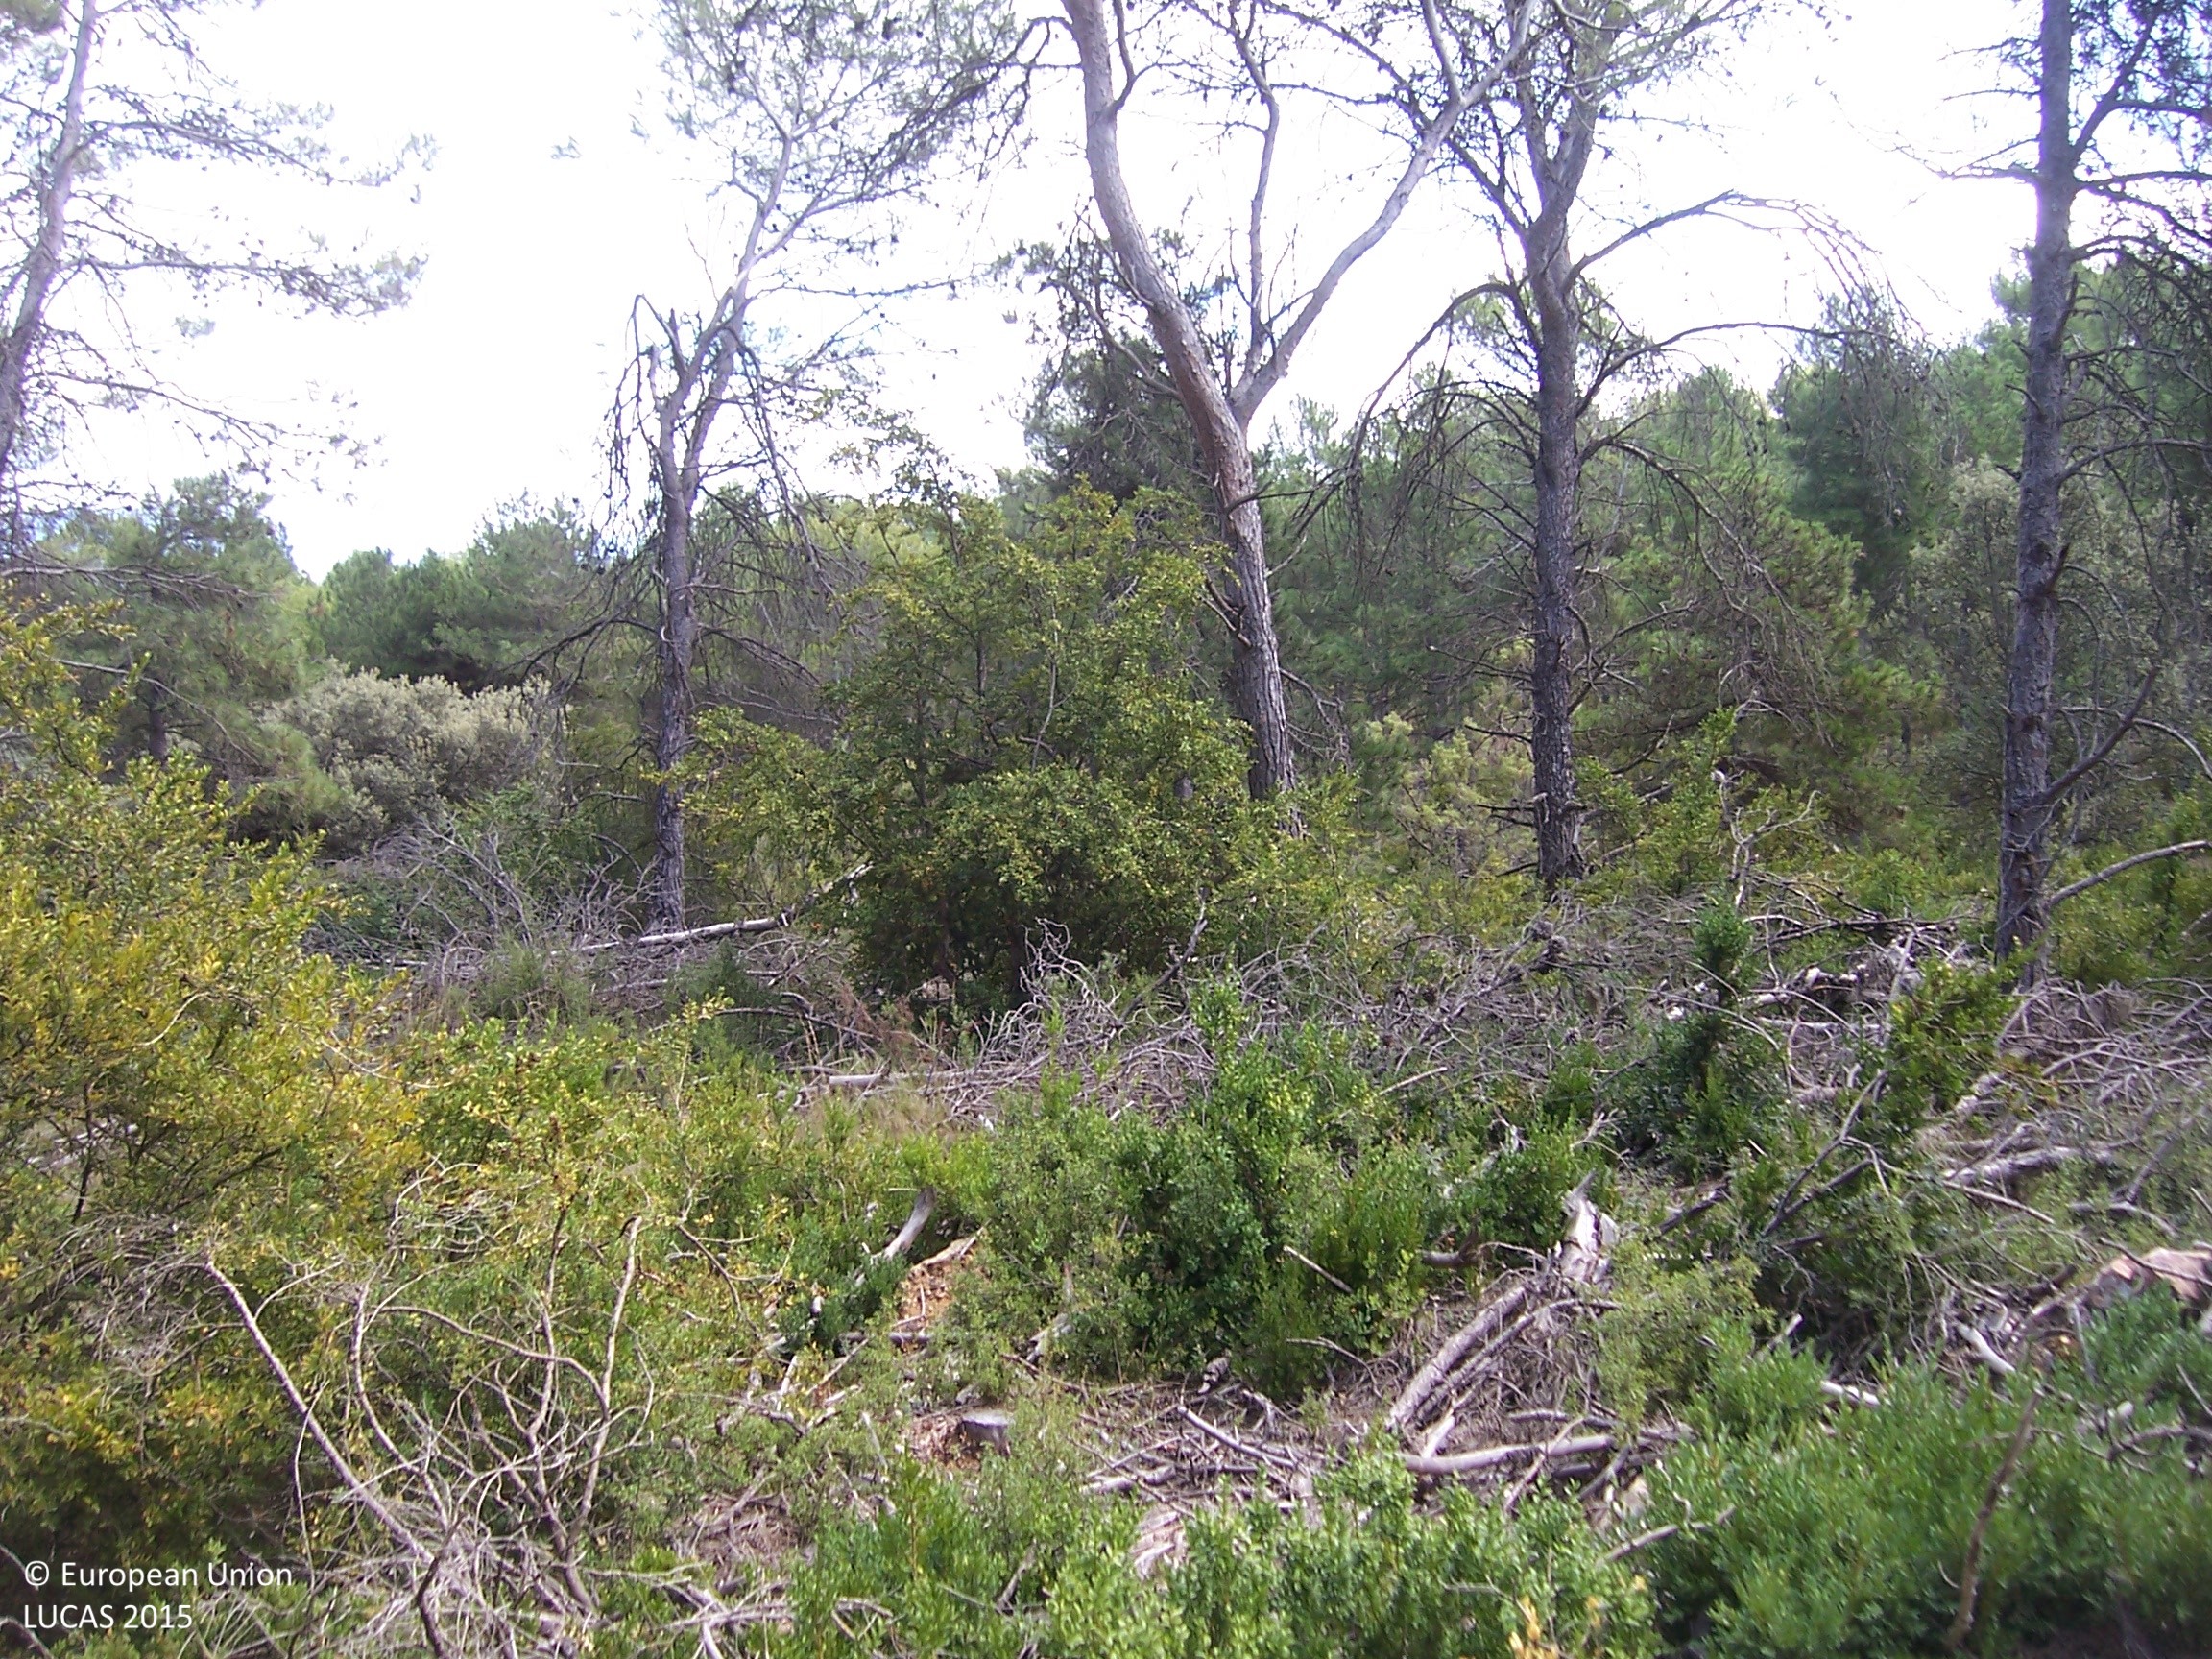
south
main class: Woodland
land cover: Pine dominated coniferous woodland
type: coniferous forest of the mediterranean region
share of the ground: 25 - 50 %
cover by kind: coniferous forest trees 40 %, shrubs 30 %, herbaceous plants 20 %, consolidated bare surface 10 %
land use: Forestry
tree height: > 5 m
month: August
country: ES
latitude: 41.9691
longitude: 0.4876
